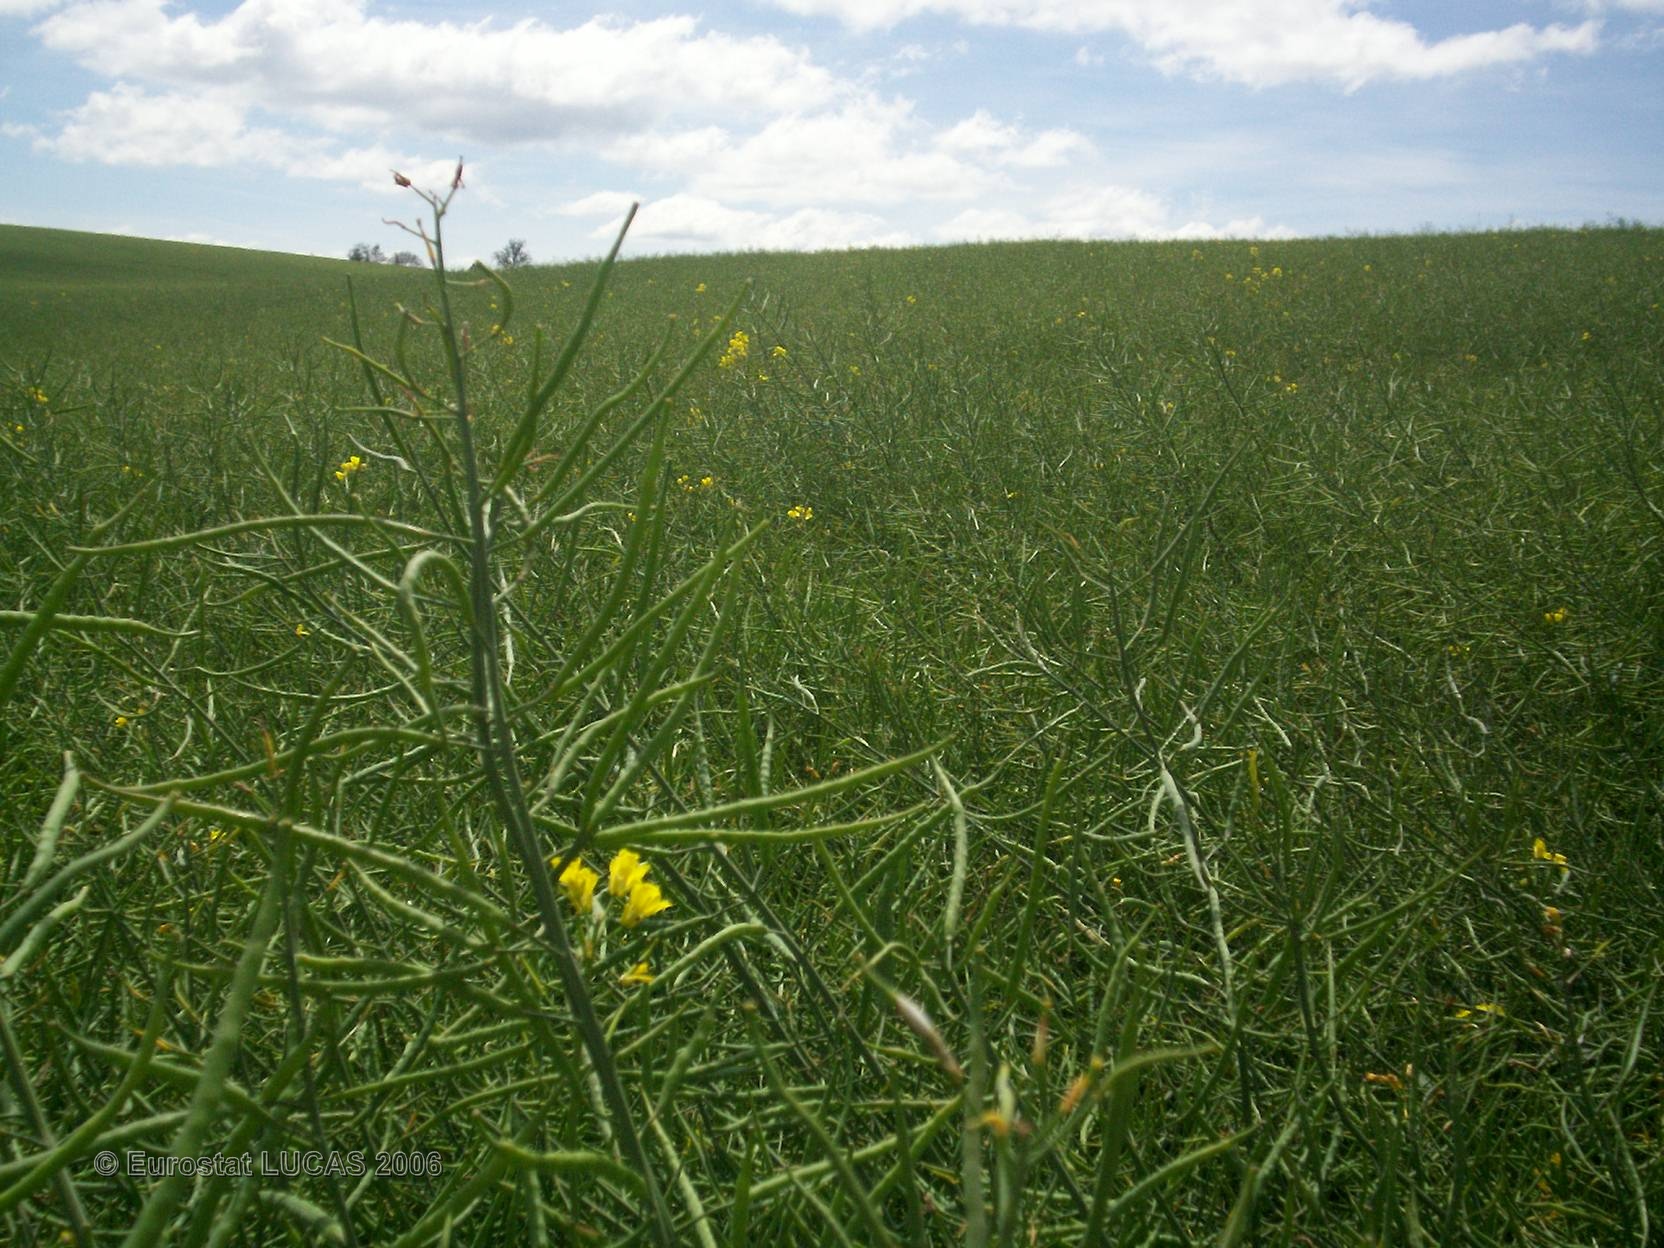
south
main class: Cropland
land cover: Rape and turnip rape
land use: Agriculture (excluding fallow land and kitchen gardens)
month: June
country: FR
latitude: 49.2307
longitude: 5.0679
